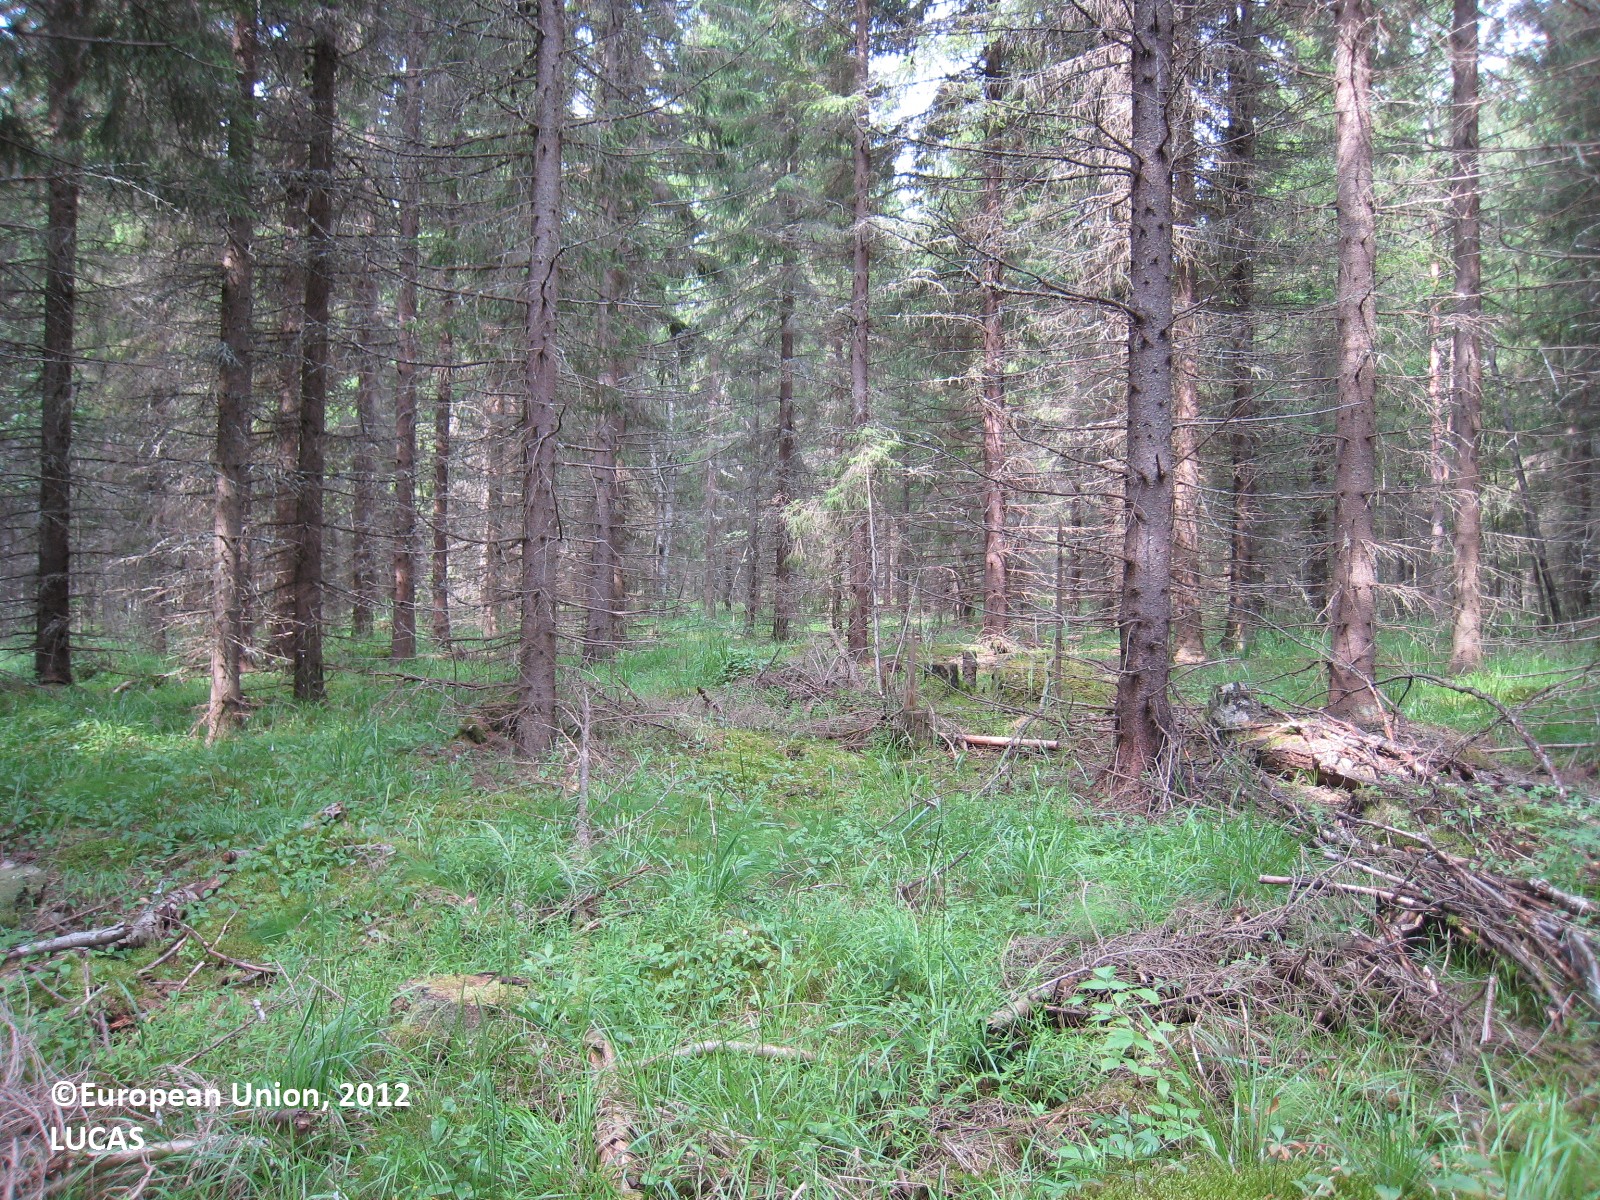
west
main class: Woodland
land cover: Spruce dominated coniferous woodland
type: boreal forest
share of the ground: 50 - 75 %
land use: Forestry
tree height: > 5 m
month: July
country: FI
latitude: 61.8721
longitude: 27.1815
